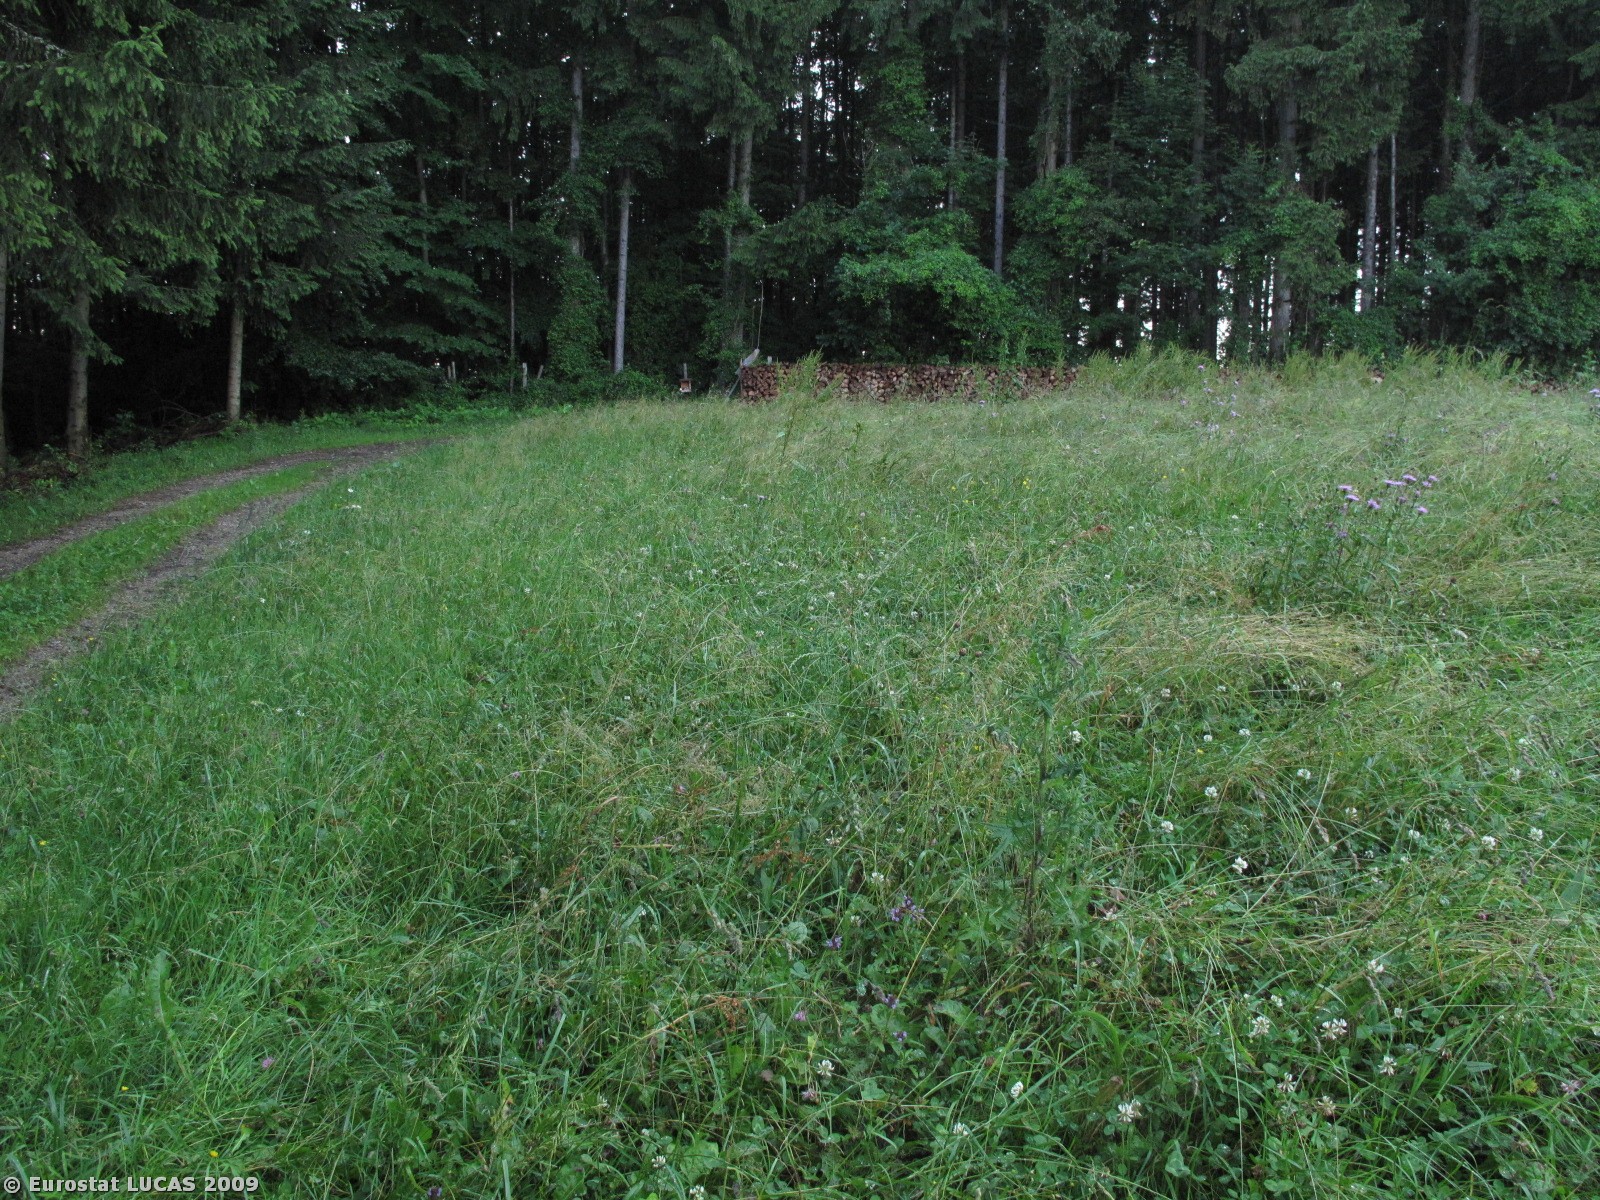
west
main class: Grassland
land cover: Grassland without tree/shrub cover
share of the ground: > 75 %
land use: Agriculture (excluding fallow land and kitchen gardens)
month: July
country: AT
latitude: 48.0163
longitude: 15.8079
